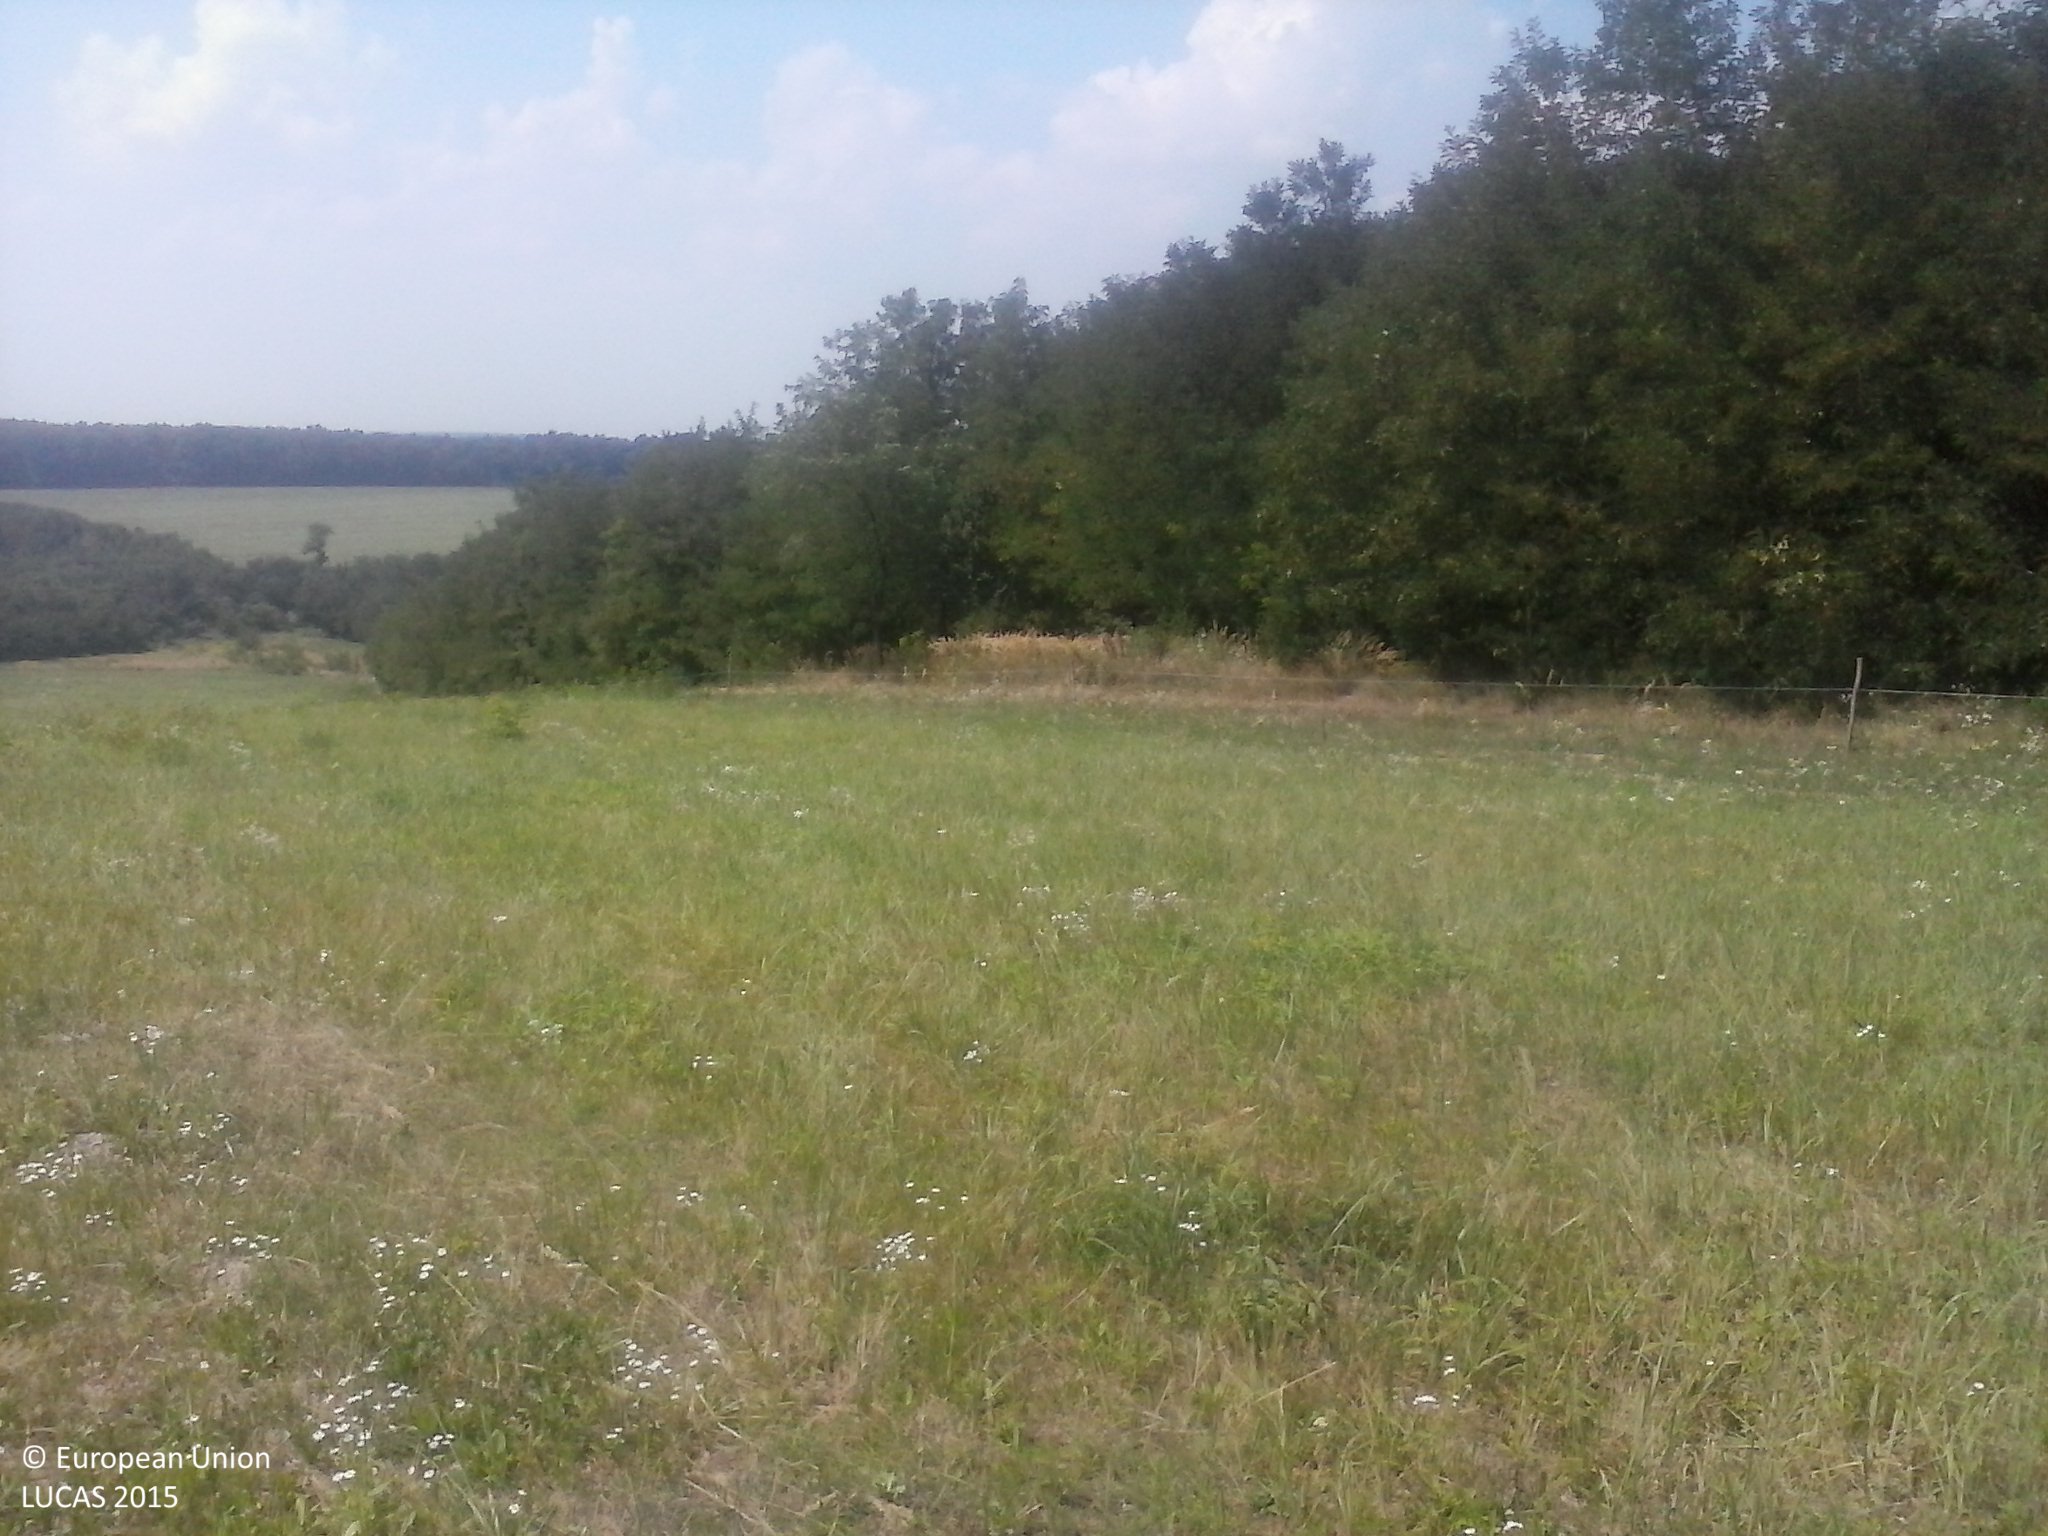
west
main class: Grassland
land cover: Grassland without tree/shrub cover
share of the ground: > 75 %
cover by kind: herbaceous plants 100 %
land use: Agriculture (excluding fallow land and kitchen gardens)
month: August
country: HU
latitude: 46.1339
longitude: 17.8622
